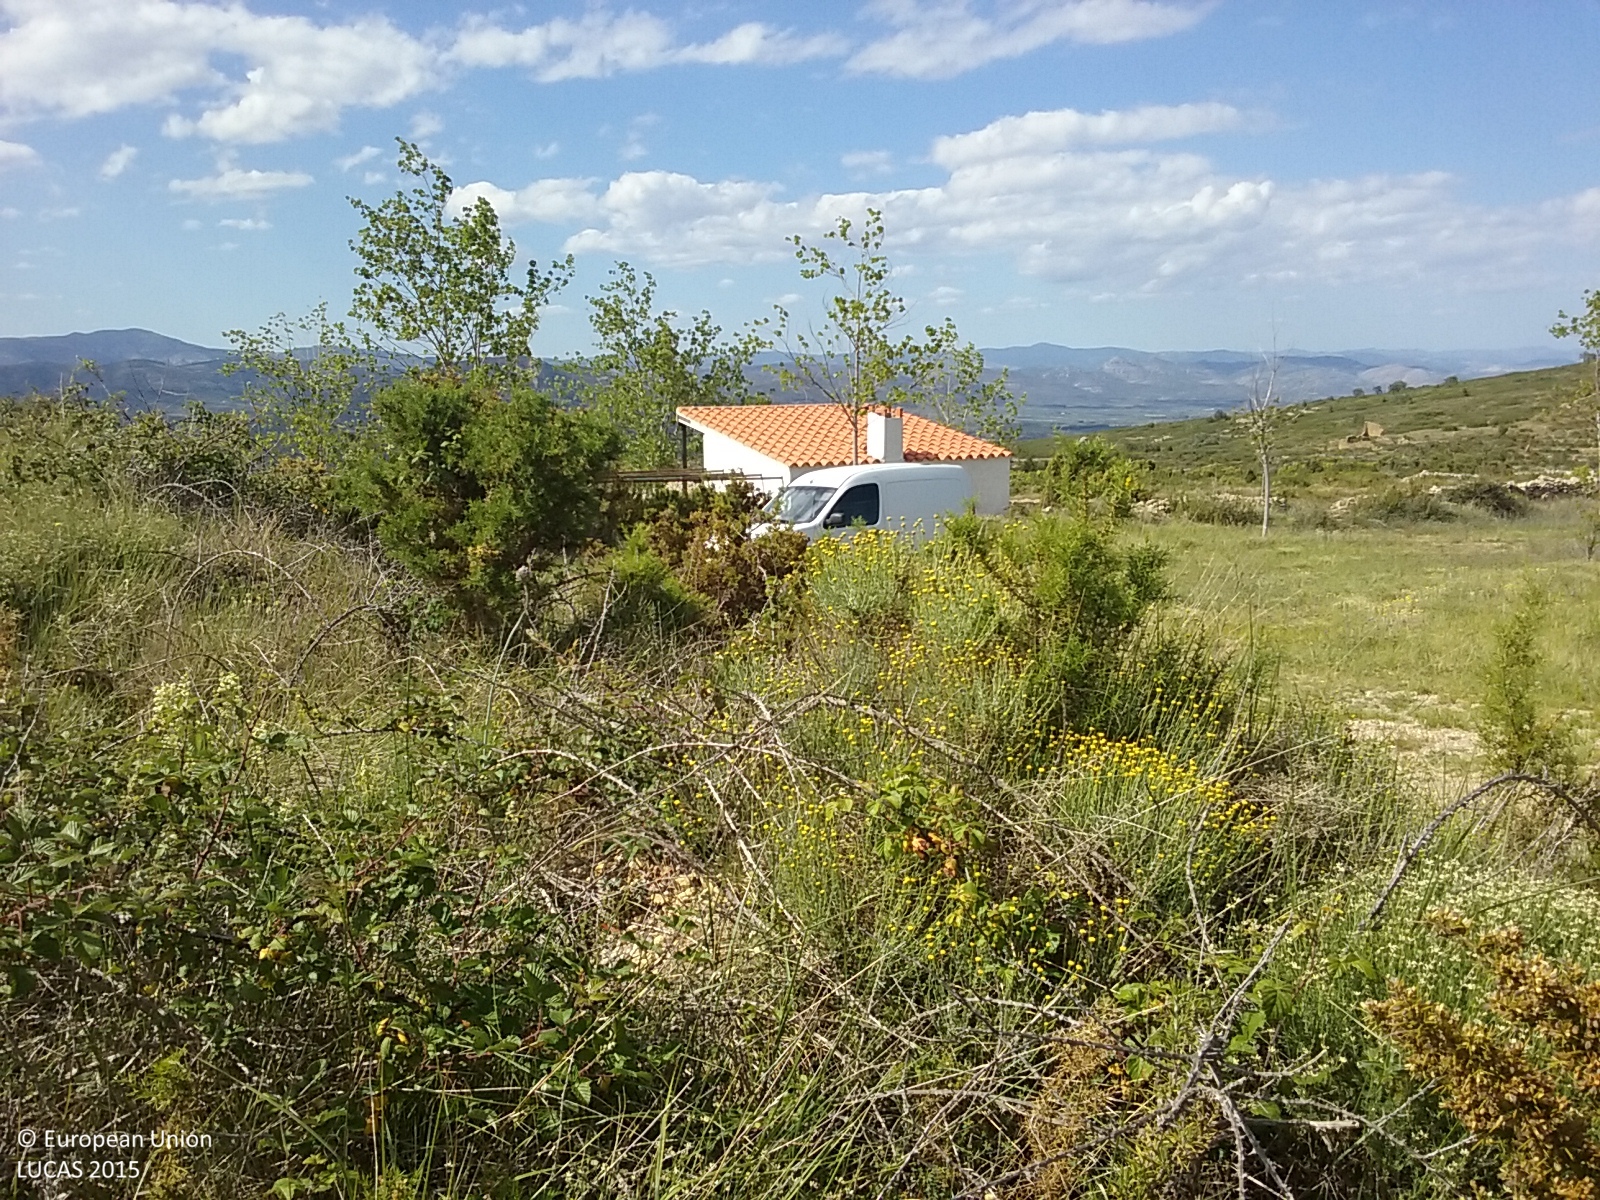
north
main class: Shrubland
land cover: Shrubland with sparse tree cover
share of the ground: > 75 %
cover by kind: shrubs 70 %, herbaceous plants 20 %, coniferous forest trees 5 %
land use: Semi-natural and natural areas not in use
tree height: < 5 m
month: May
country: ES
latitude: 40.3430
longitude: 0.0483
